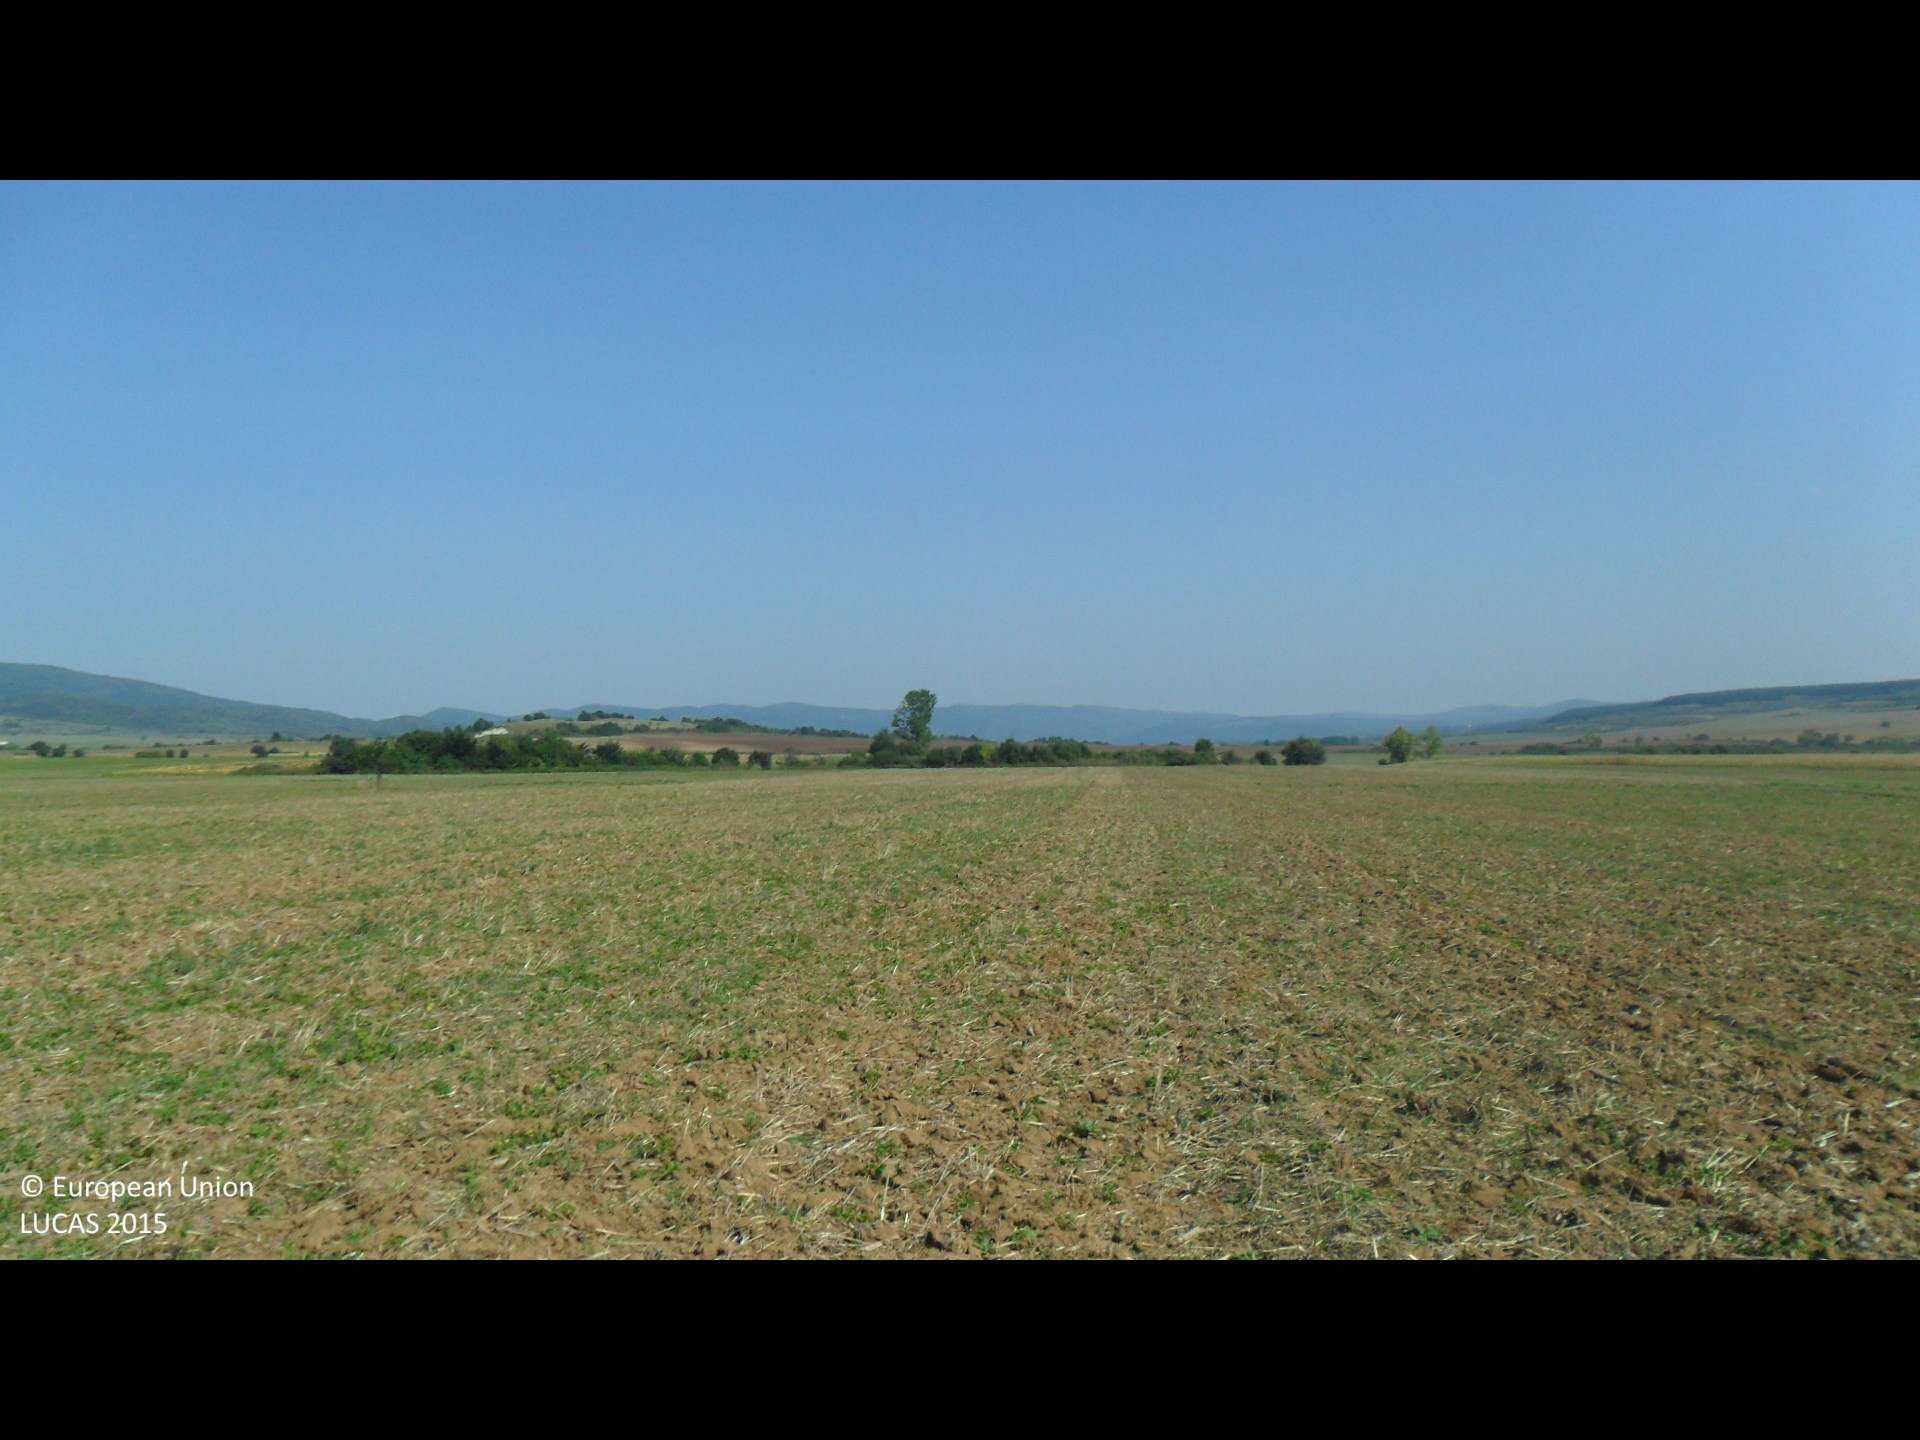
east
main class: Cropland
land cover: Common wheat
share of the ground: < 10 %
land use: Agriculture (excluding fallow land and kitchen gardens)
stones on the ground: < 10 %
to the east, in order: Common wheat
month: September
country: BG
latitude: 43.0994
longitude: 26.6788
